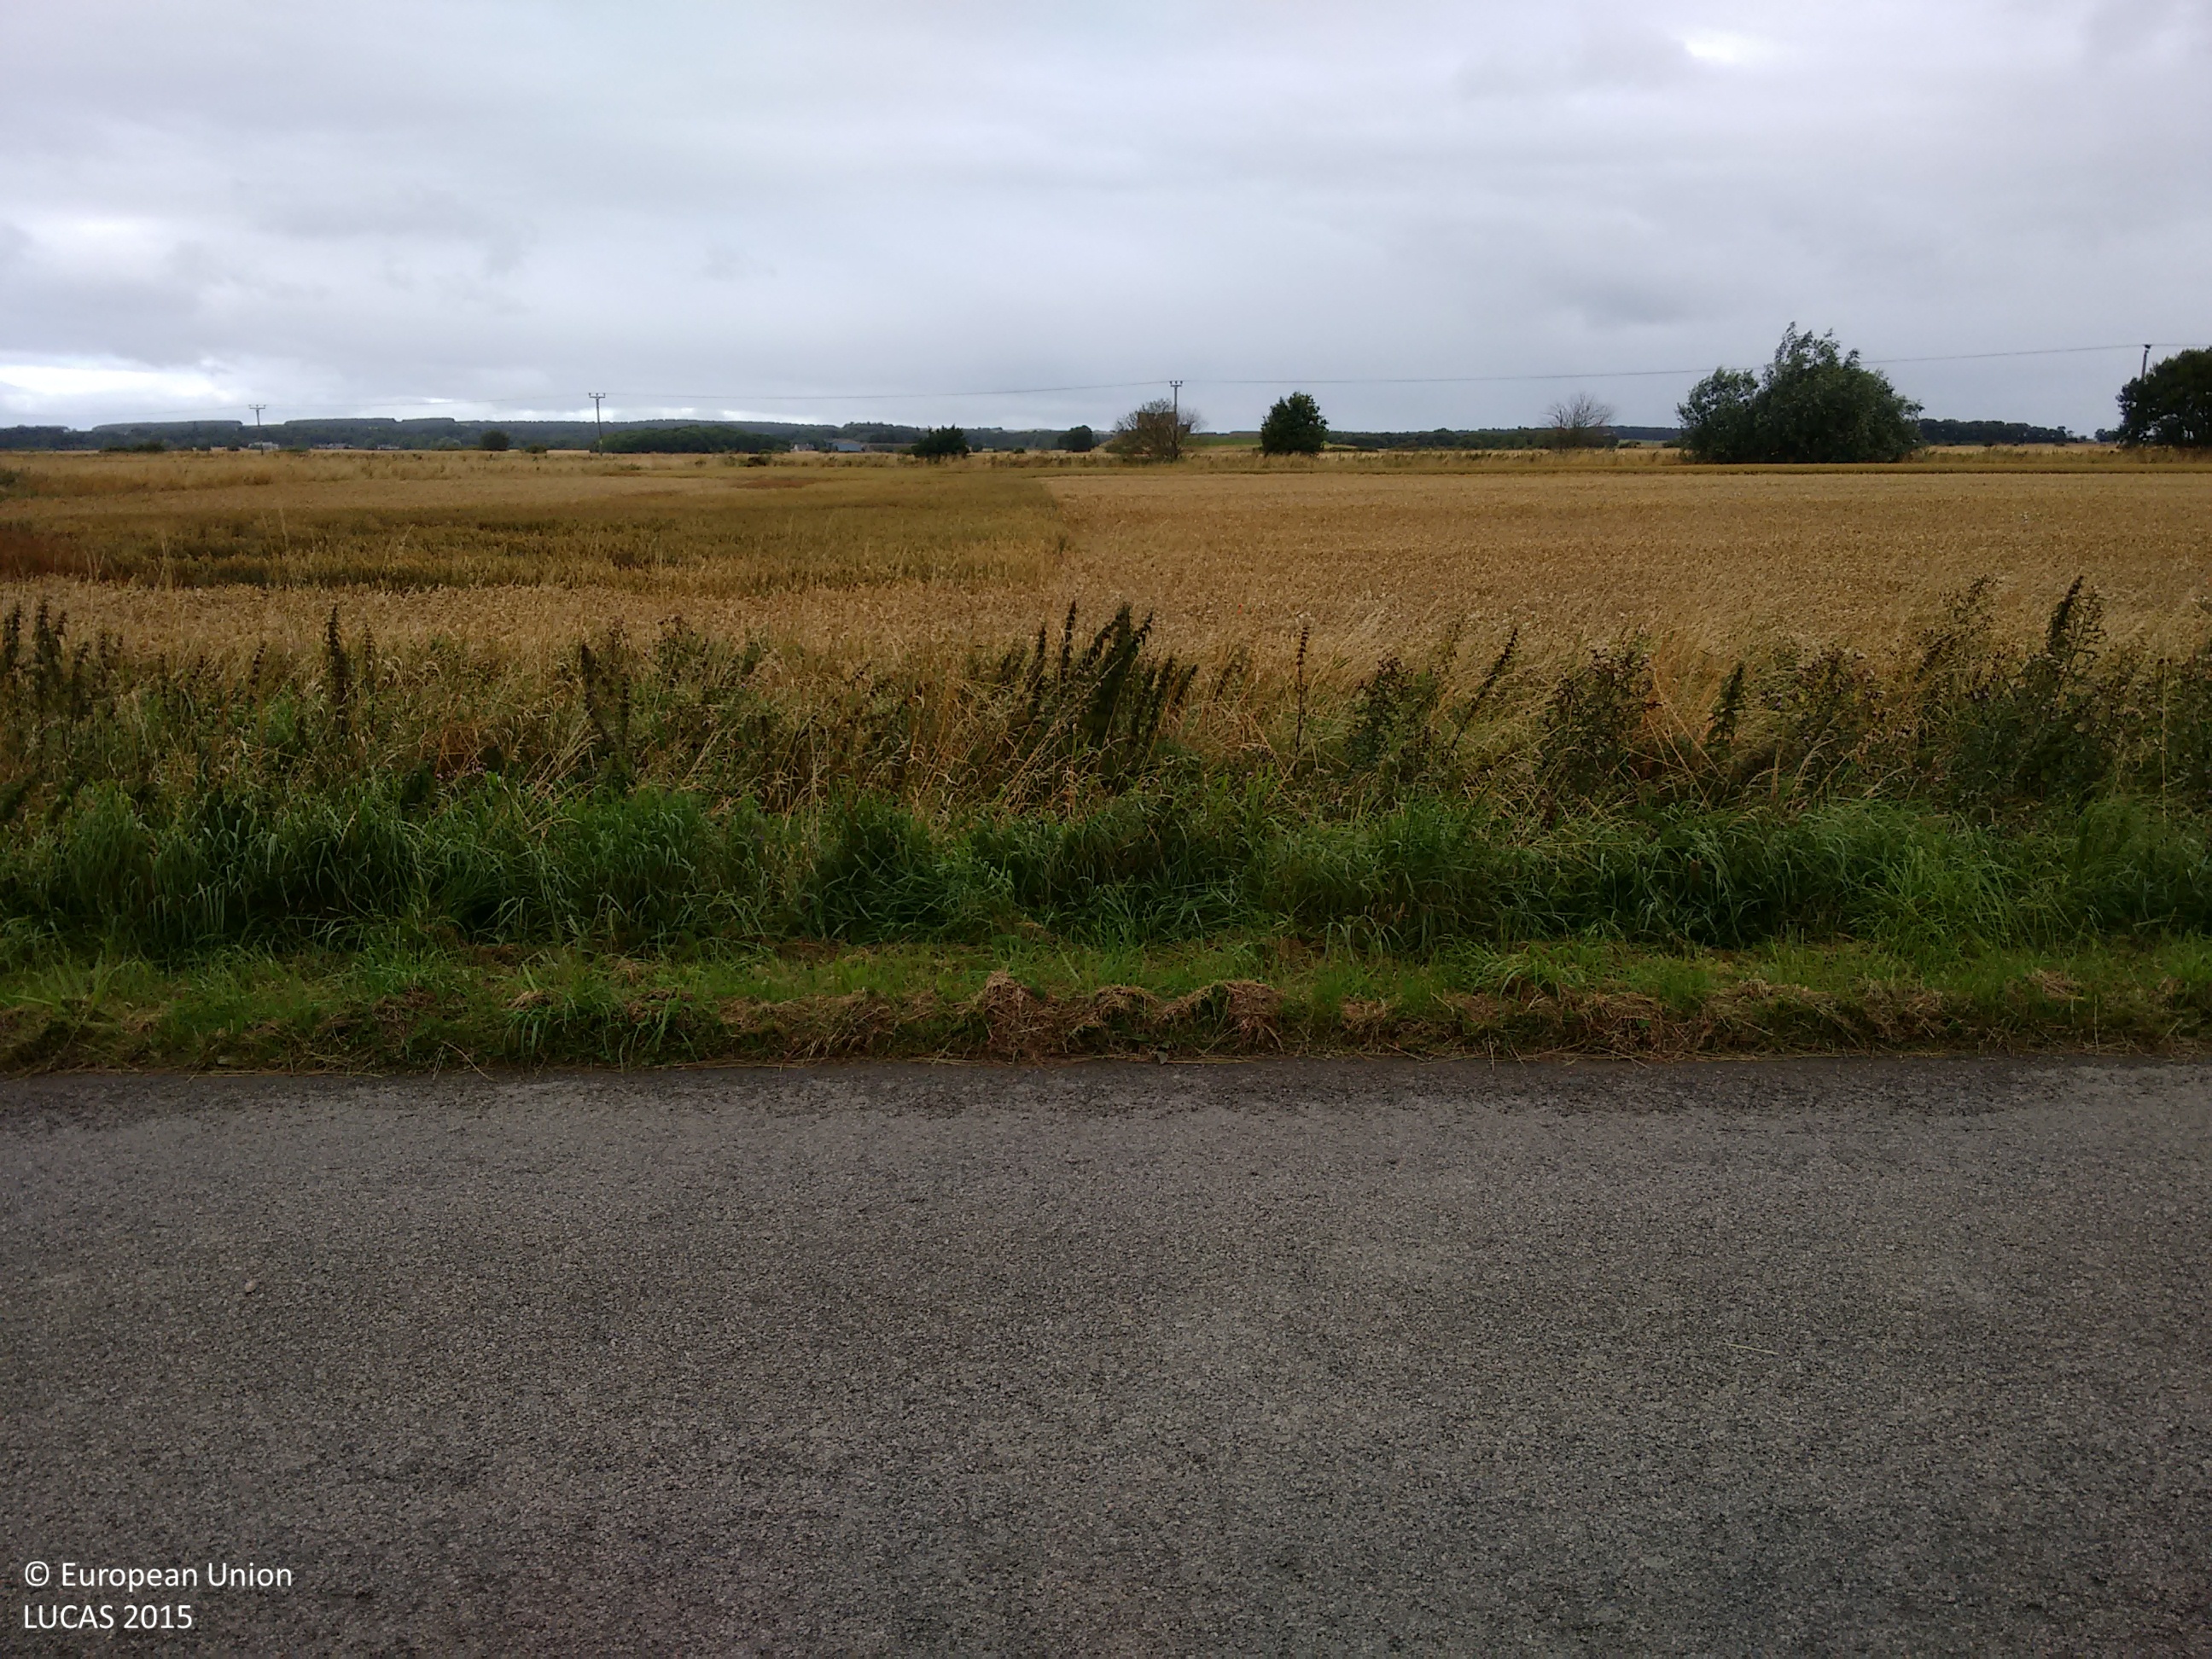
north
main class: Cropland
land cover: Barley
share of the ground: > 75 %
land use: Agriculture (excluding fallow land and kitchen gardens)
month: September
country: GB
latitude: 57.6759
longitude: -3.3639
